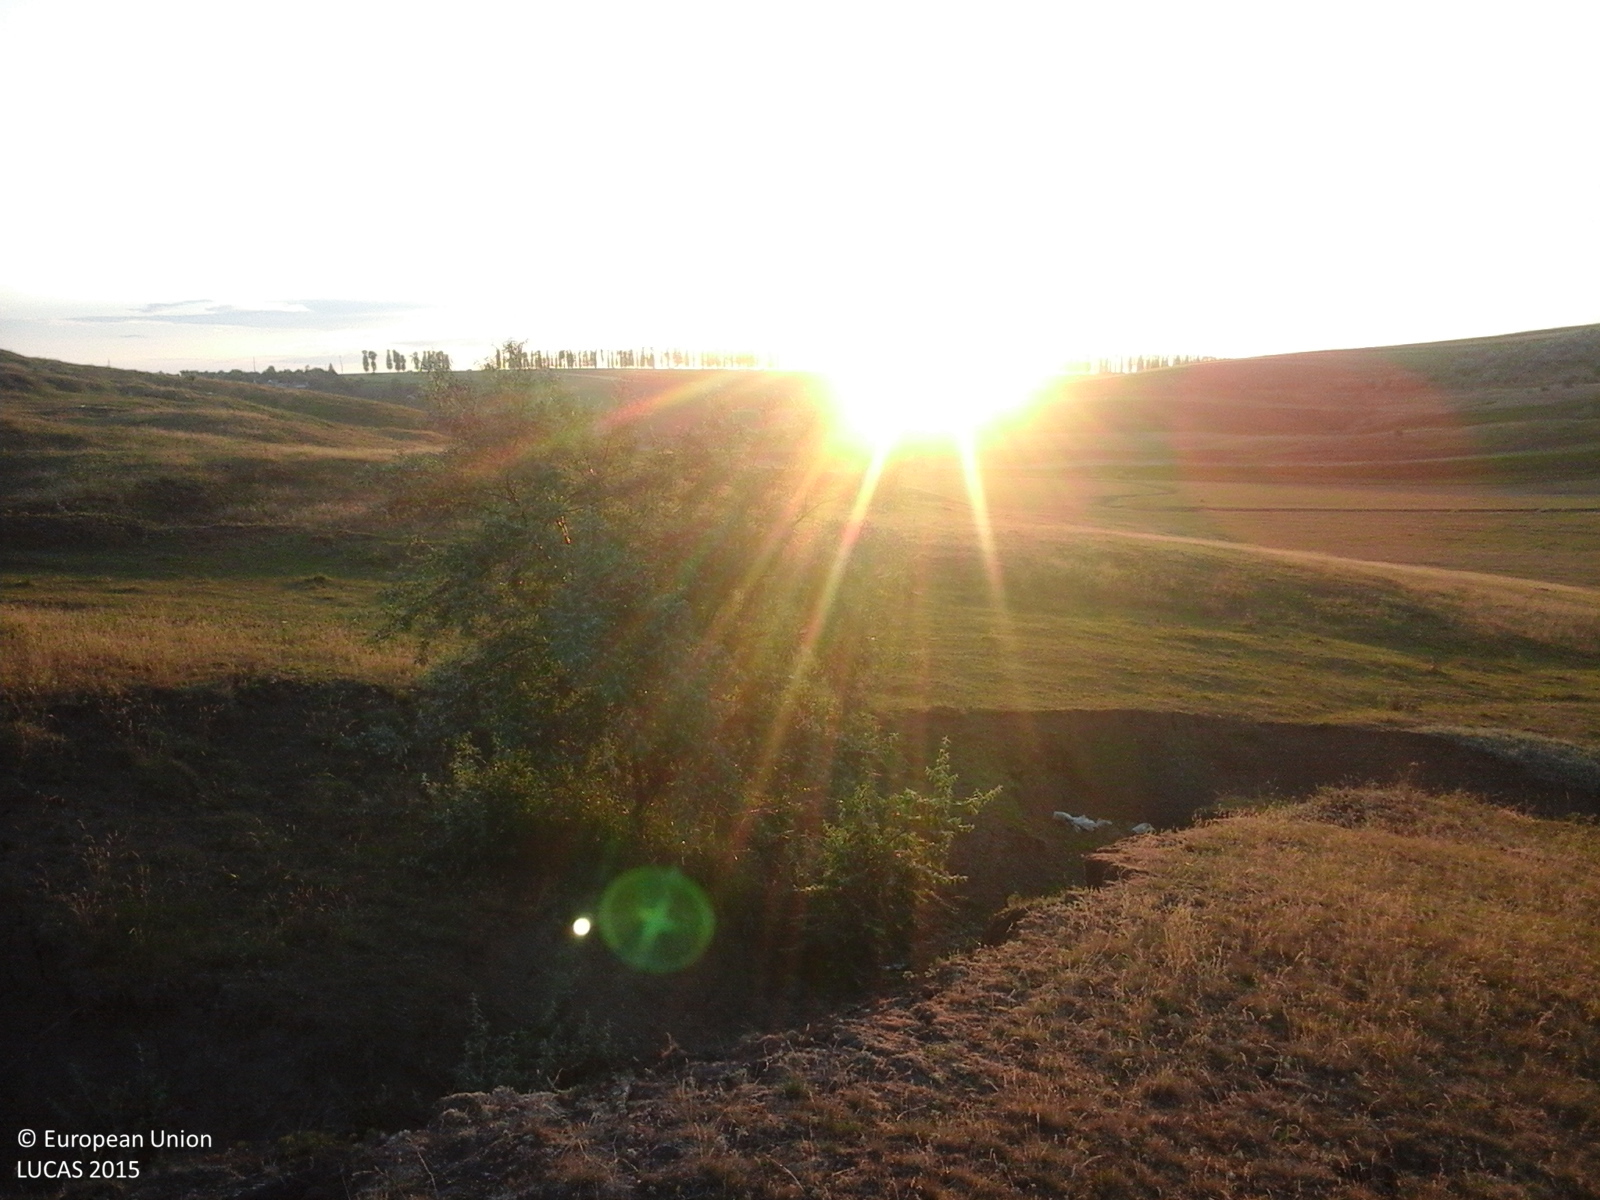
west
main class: Grassland
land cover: Grassland without tree/shrub cover
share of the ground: > 75 %
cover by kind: herbaceous plants 100 %
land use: Agriculture (excluding fallow land and kitchen gardens)
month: June
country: RO
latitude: 47.7605
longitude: 26.8435
